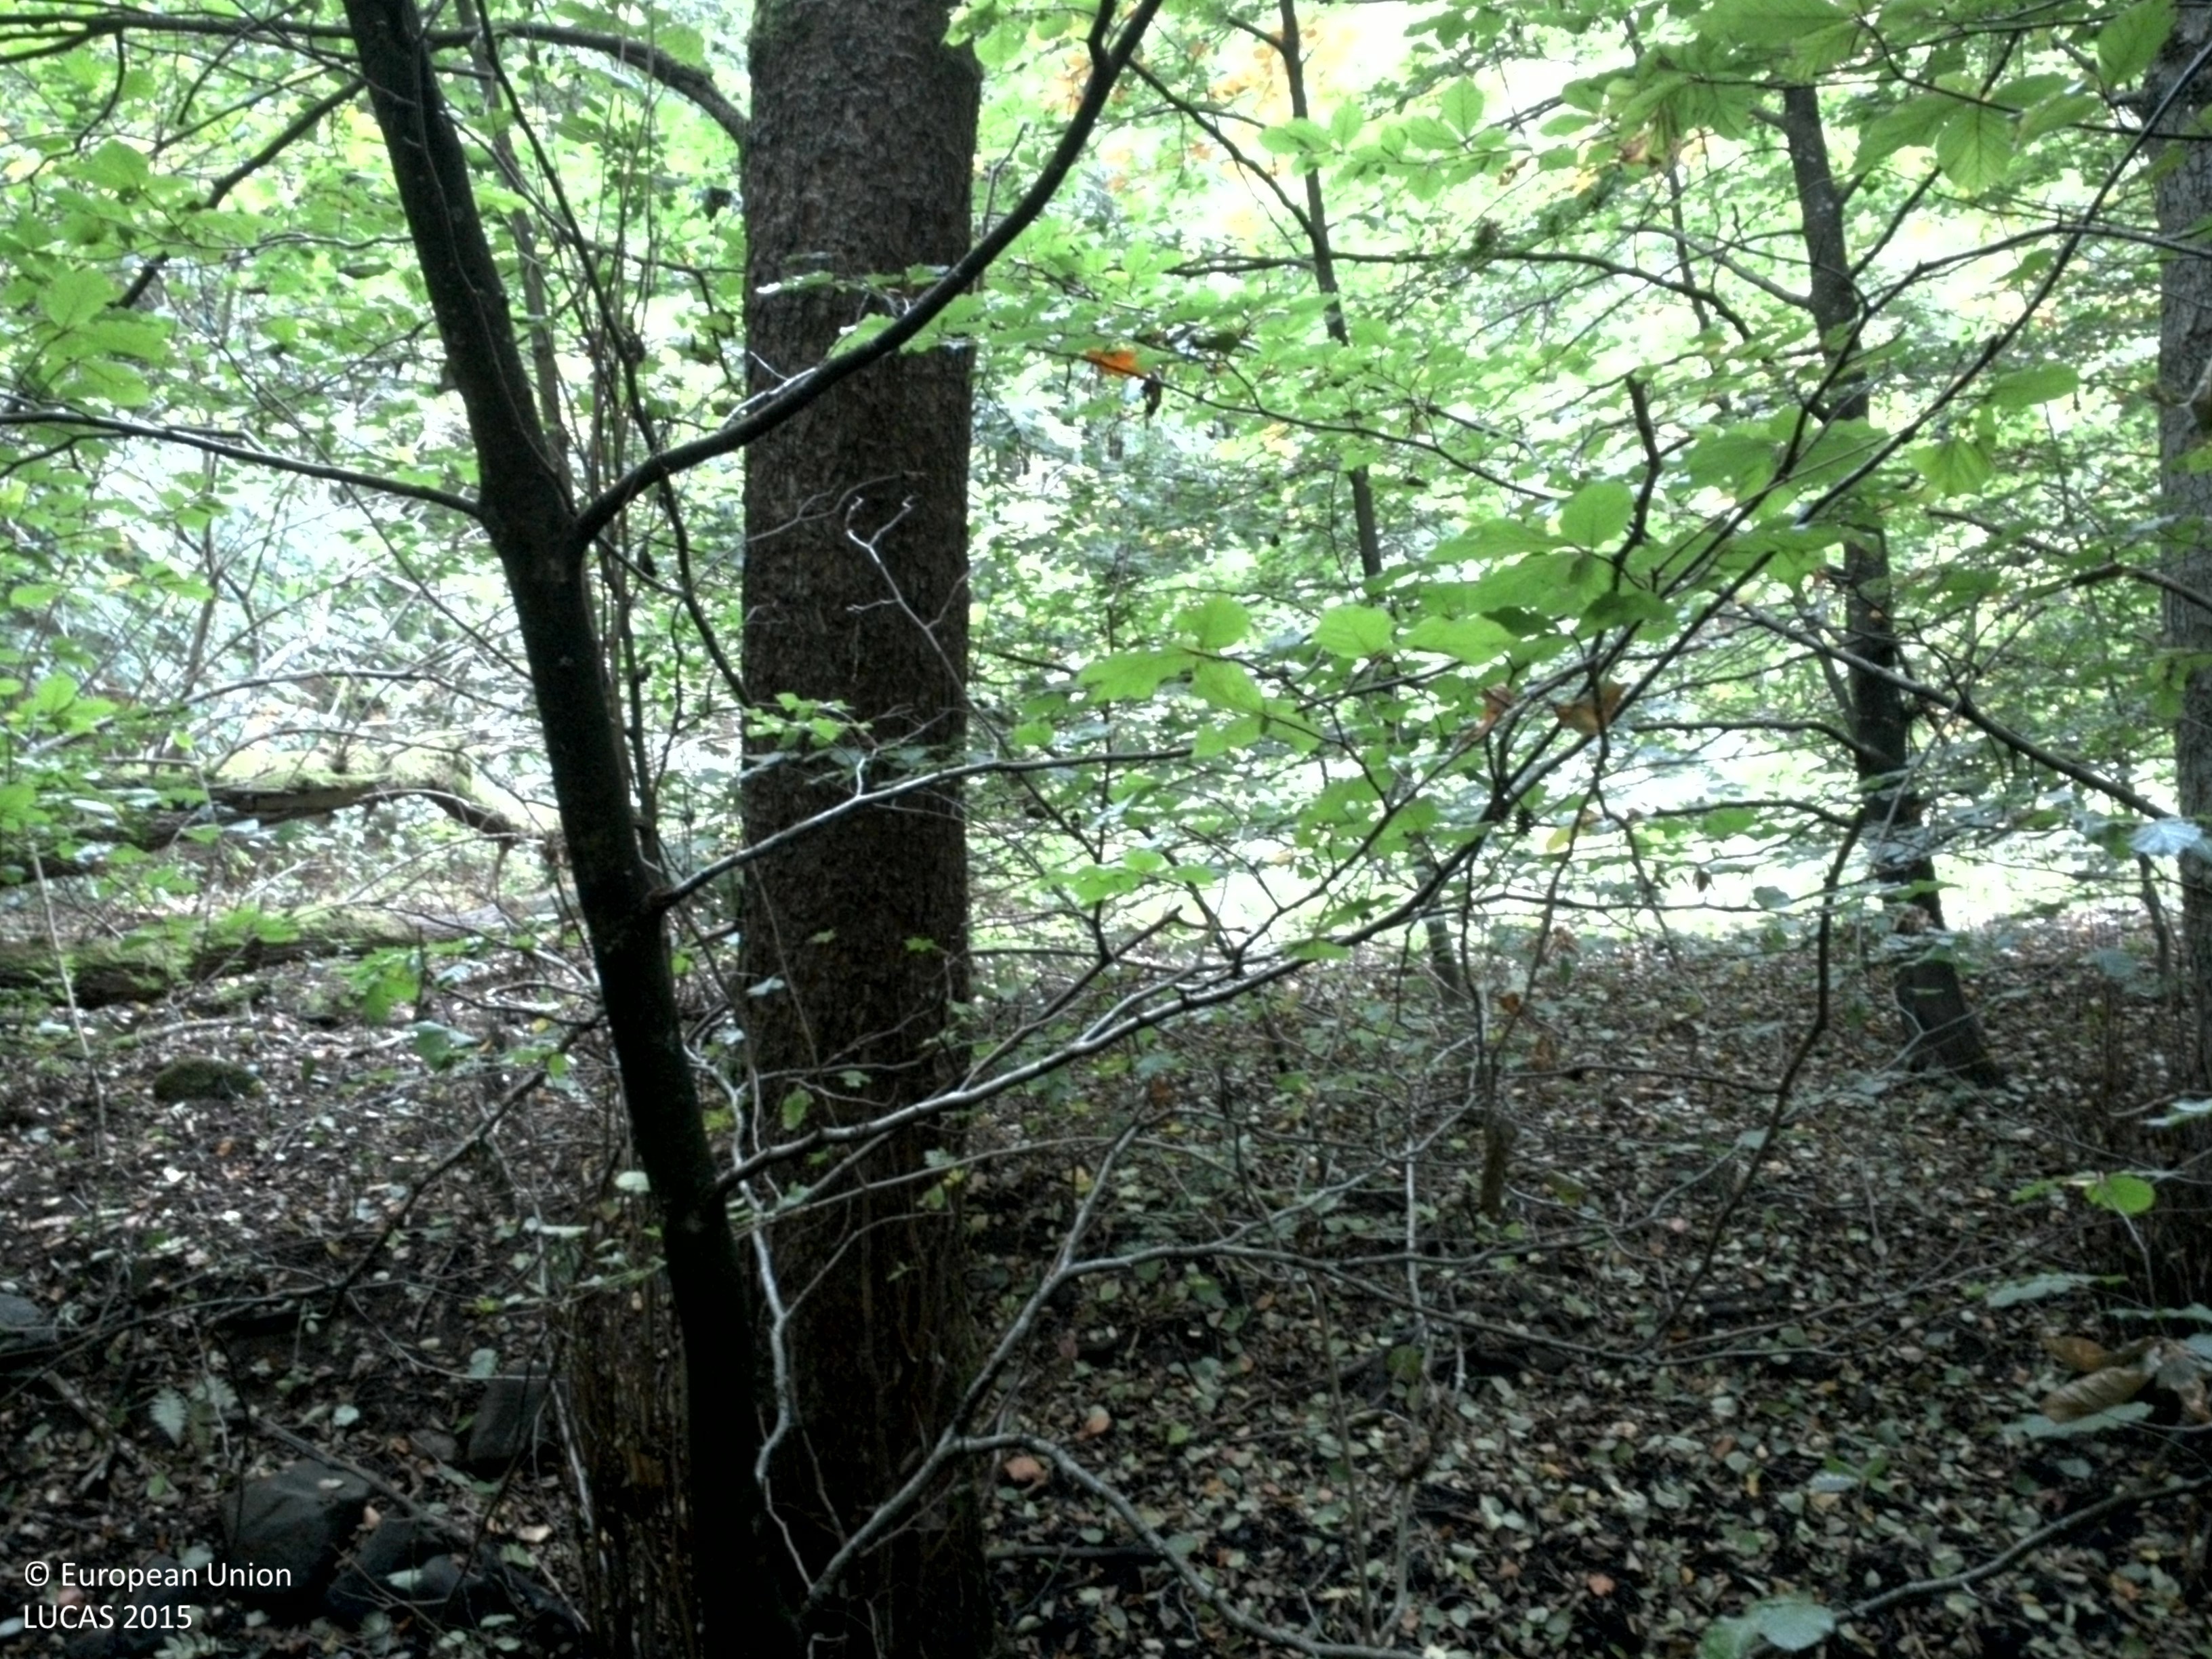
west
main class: Woodland
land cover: Broadleaved woodland
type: beech forest
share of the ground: > 75 %
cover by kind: broadleaved forest trees 80 %, unconsolidated bare surface 10 %, shrubs 5 %, herbaceous plants 5 %
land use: Forestry
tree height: > 5 m
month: October
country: SE
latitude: 55.6379
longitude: 14.0494
